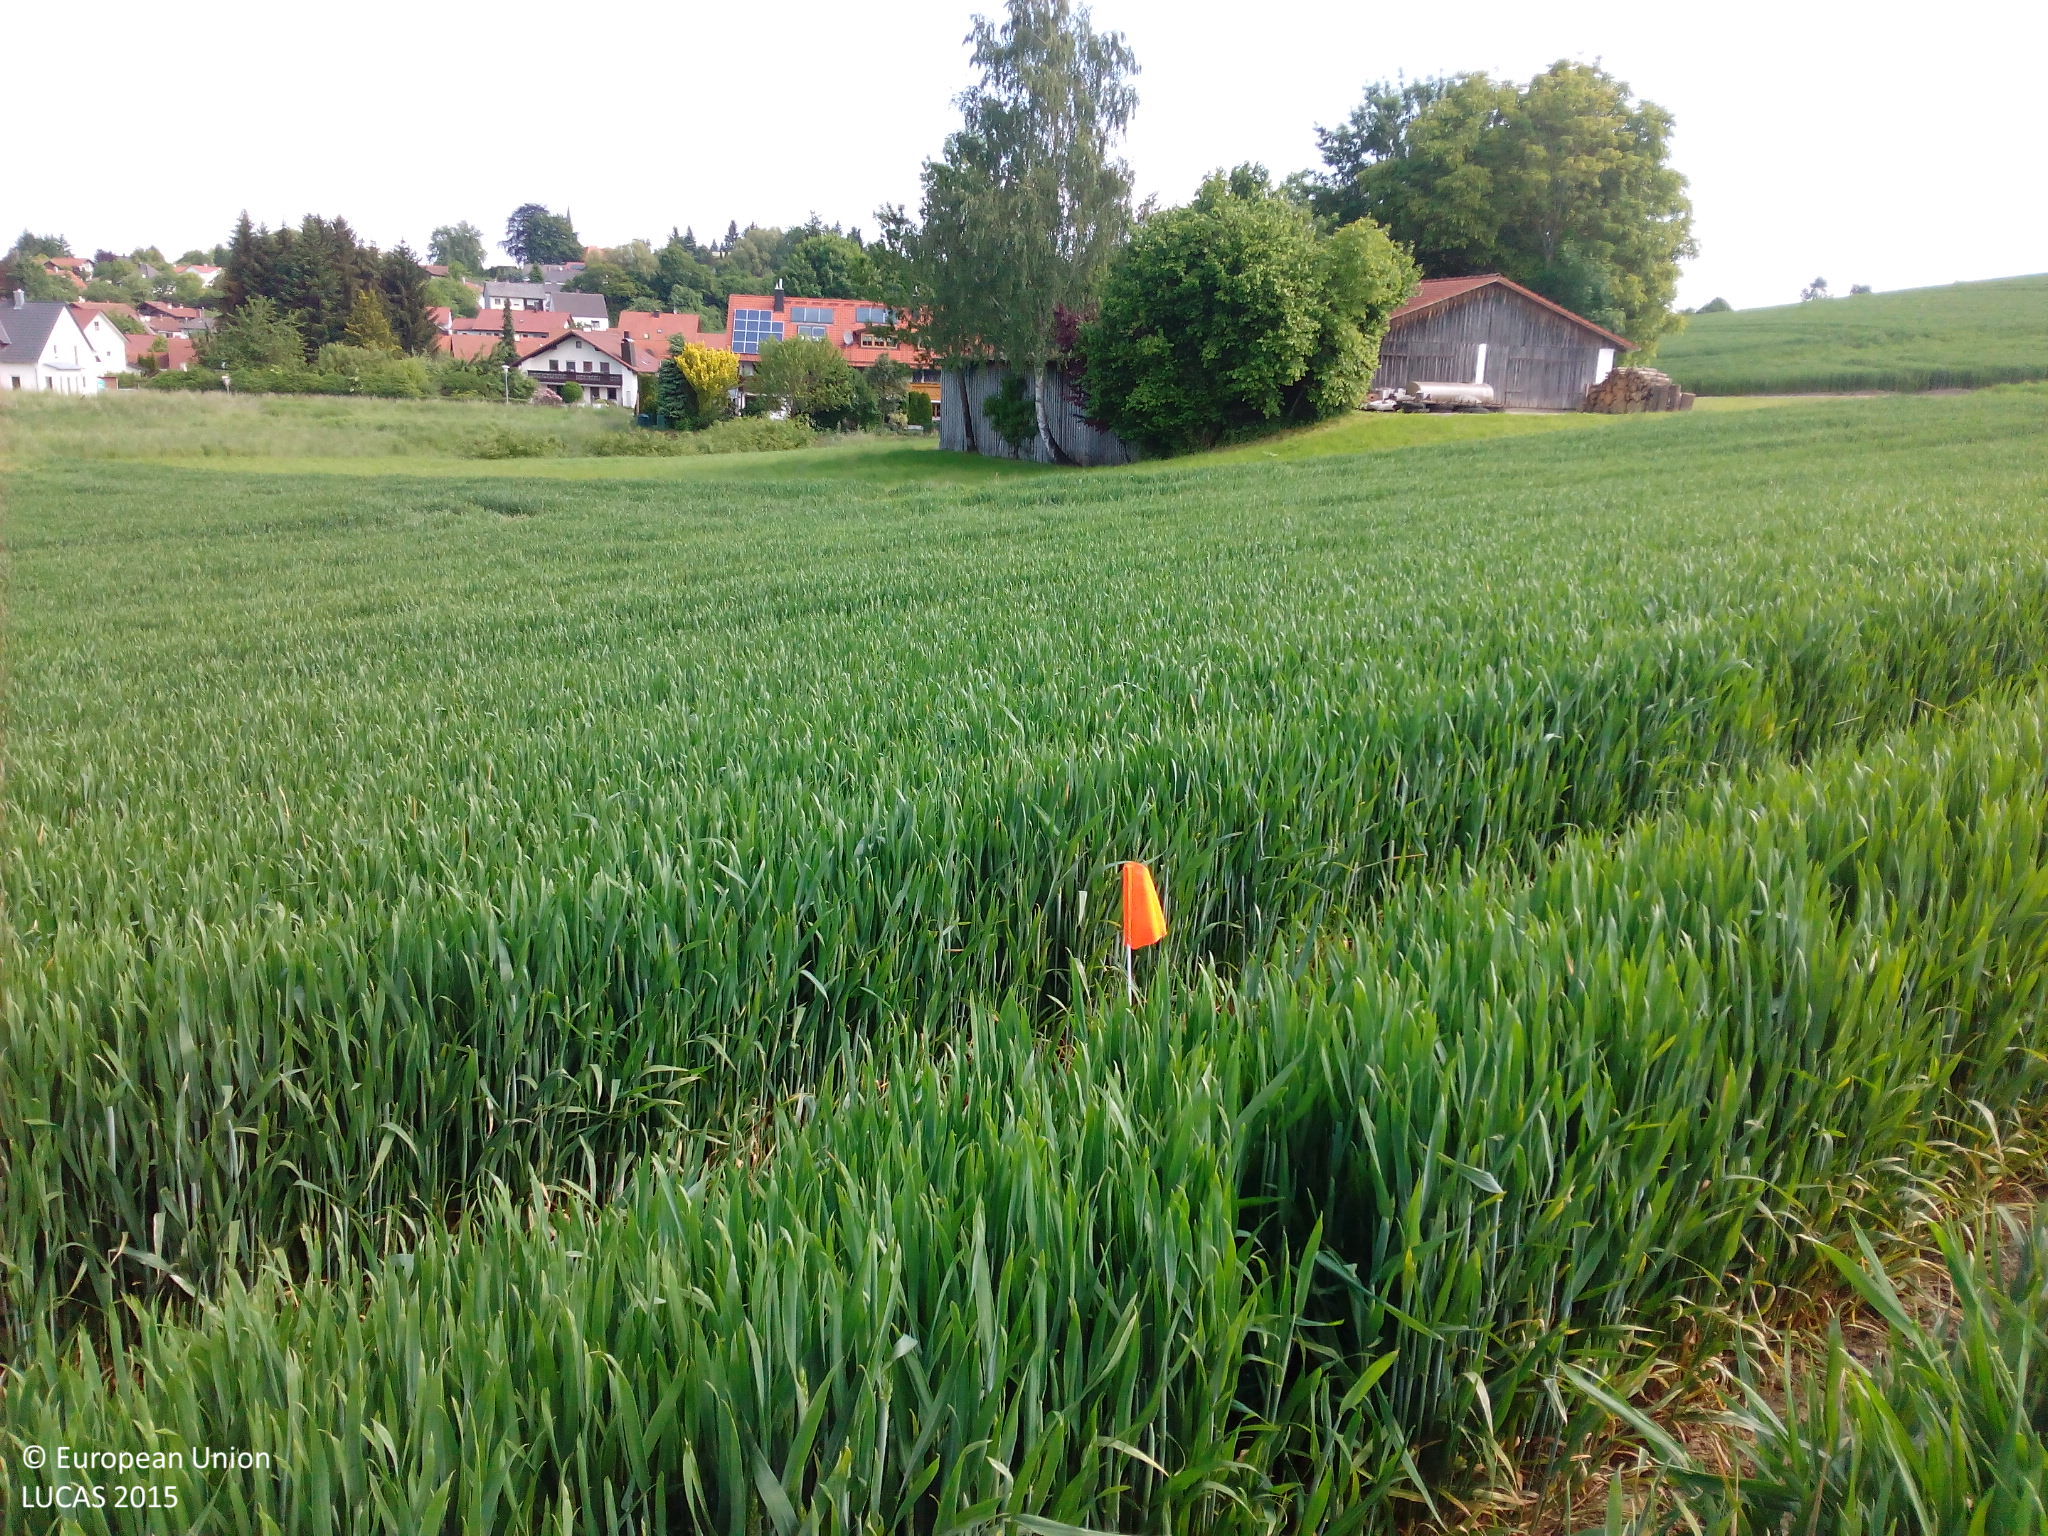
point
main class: Cropland
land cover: Common wheat
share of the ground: > 75 %
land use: Agriculture (excluding fallow land and kitchen gardens)
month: June
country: DE
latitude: 48.3794
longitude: 12.3079
